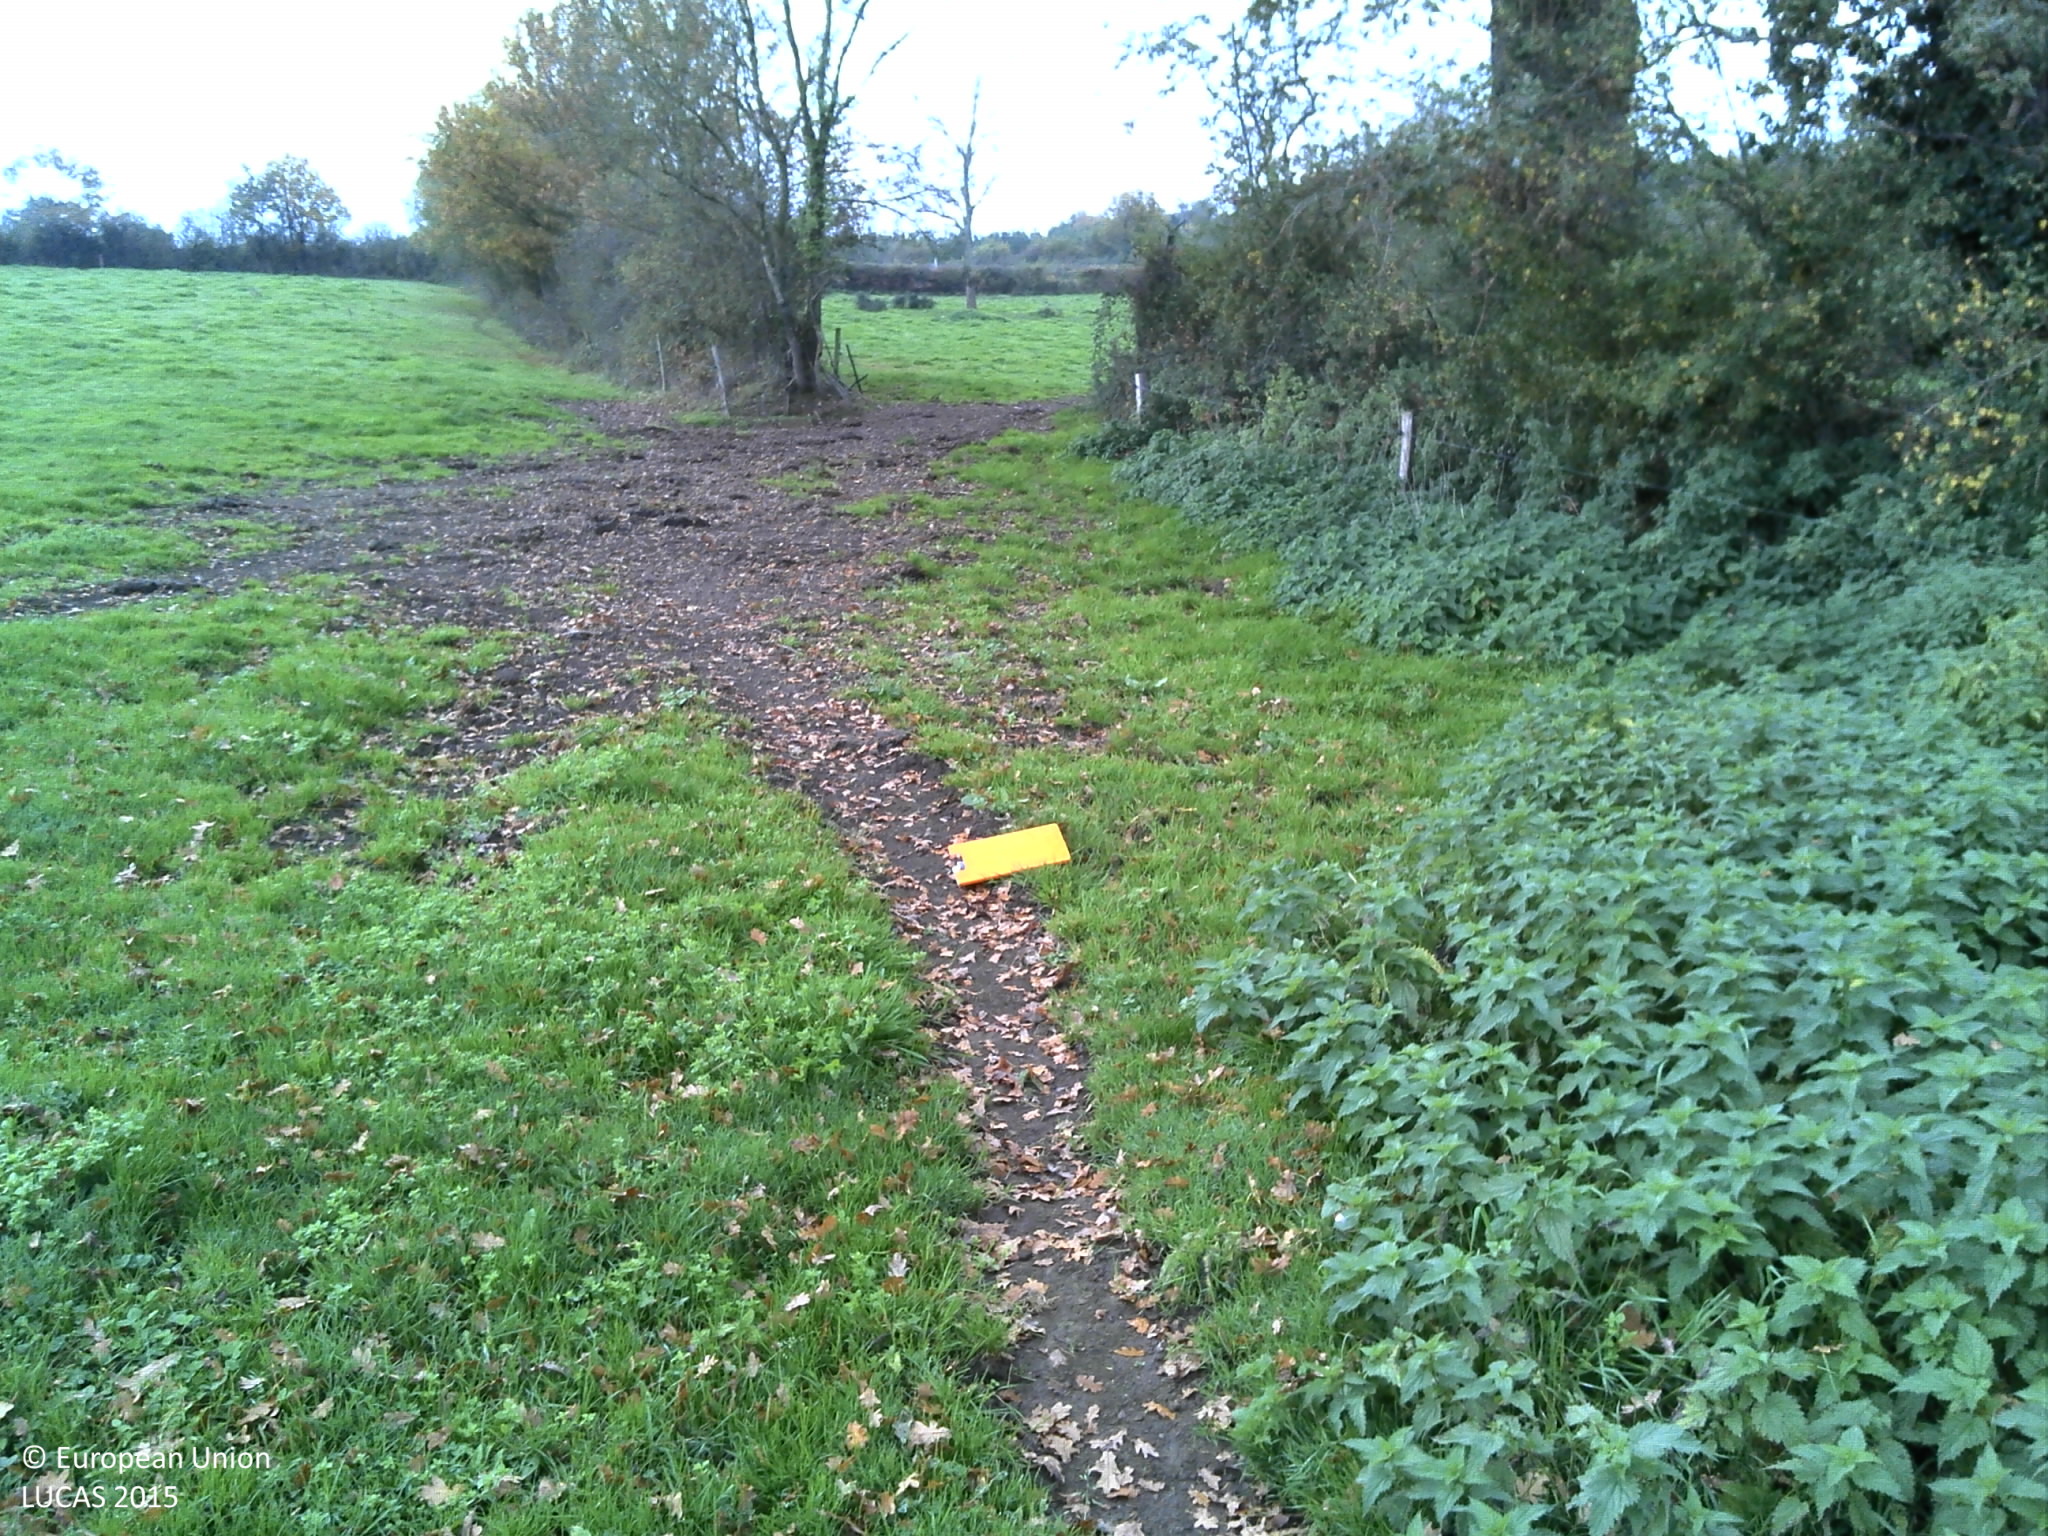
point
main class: Grassland
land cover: Grassland without tree/shrub cover
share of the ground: > 75 %
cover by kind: herbaceous plants 85 %, unconsolidated bare surface 15 %
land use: Agriculture (excluding fallow land and kitchen gardens)
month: November
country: FR
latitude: 47.3875
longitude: -1.2863
